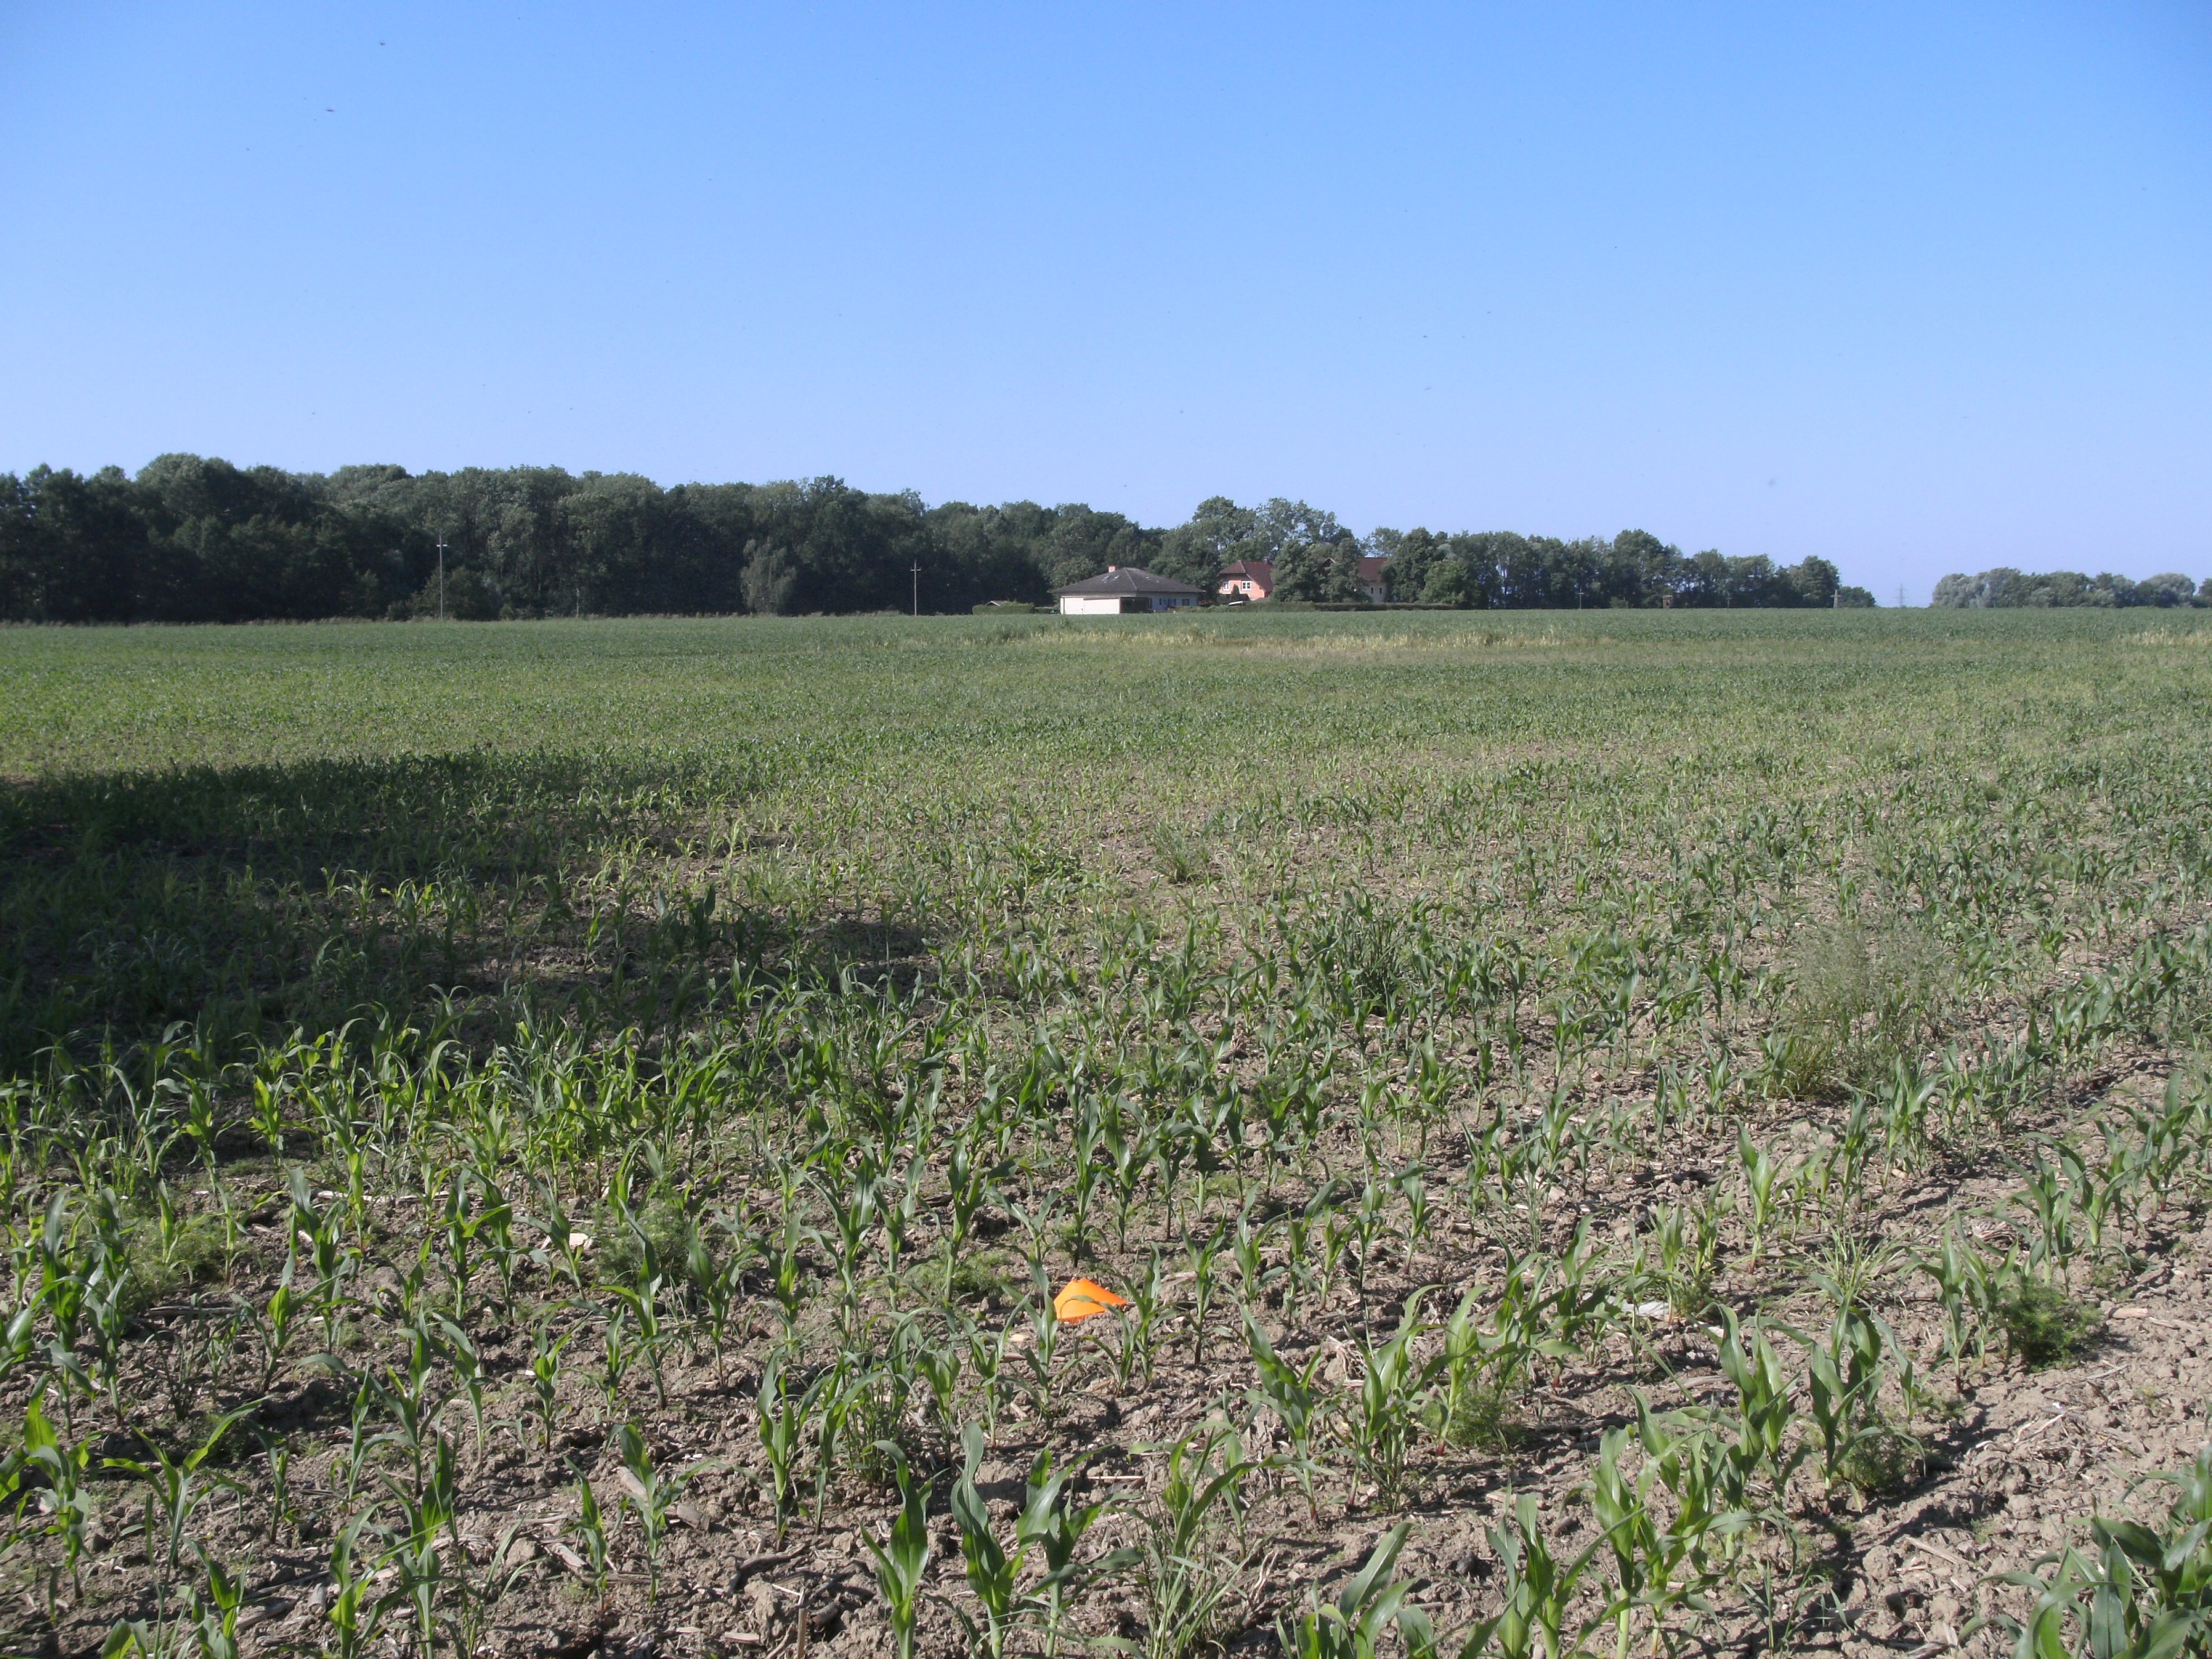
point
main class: Cropland
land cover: Maize
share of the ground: 25 - 50 %
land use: Agriculture (excluding fallow land and kitchen gardens)
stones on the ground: < 10 %
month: June
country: AT
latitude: 48.2032
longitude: 14.0498
